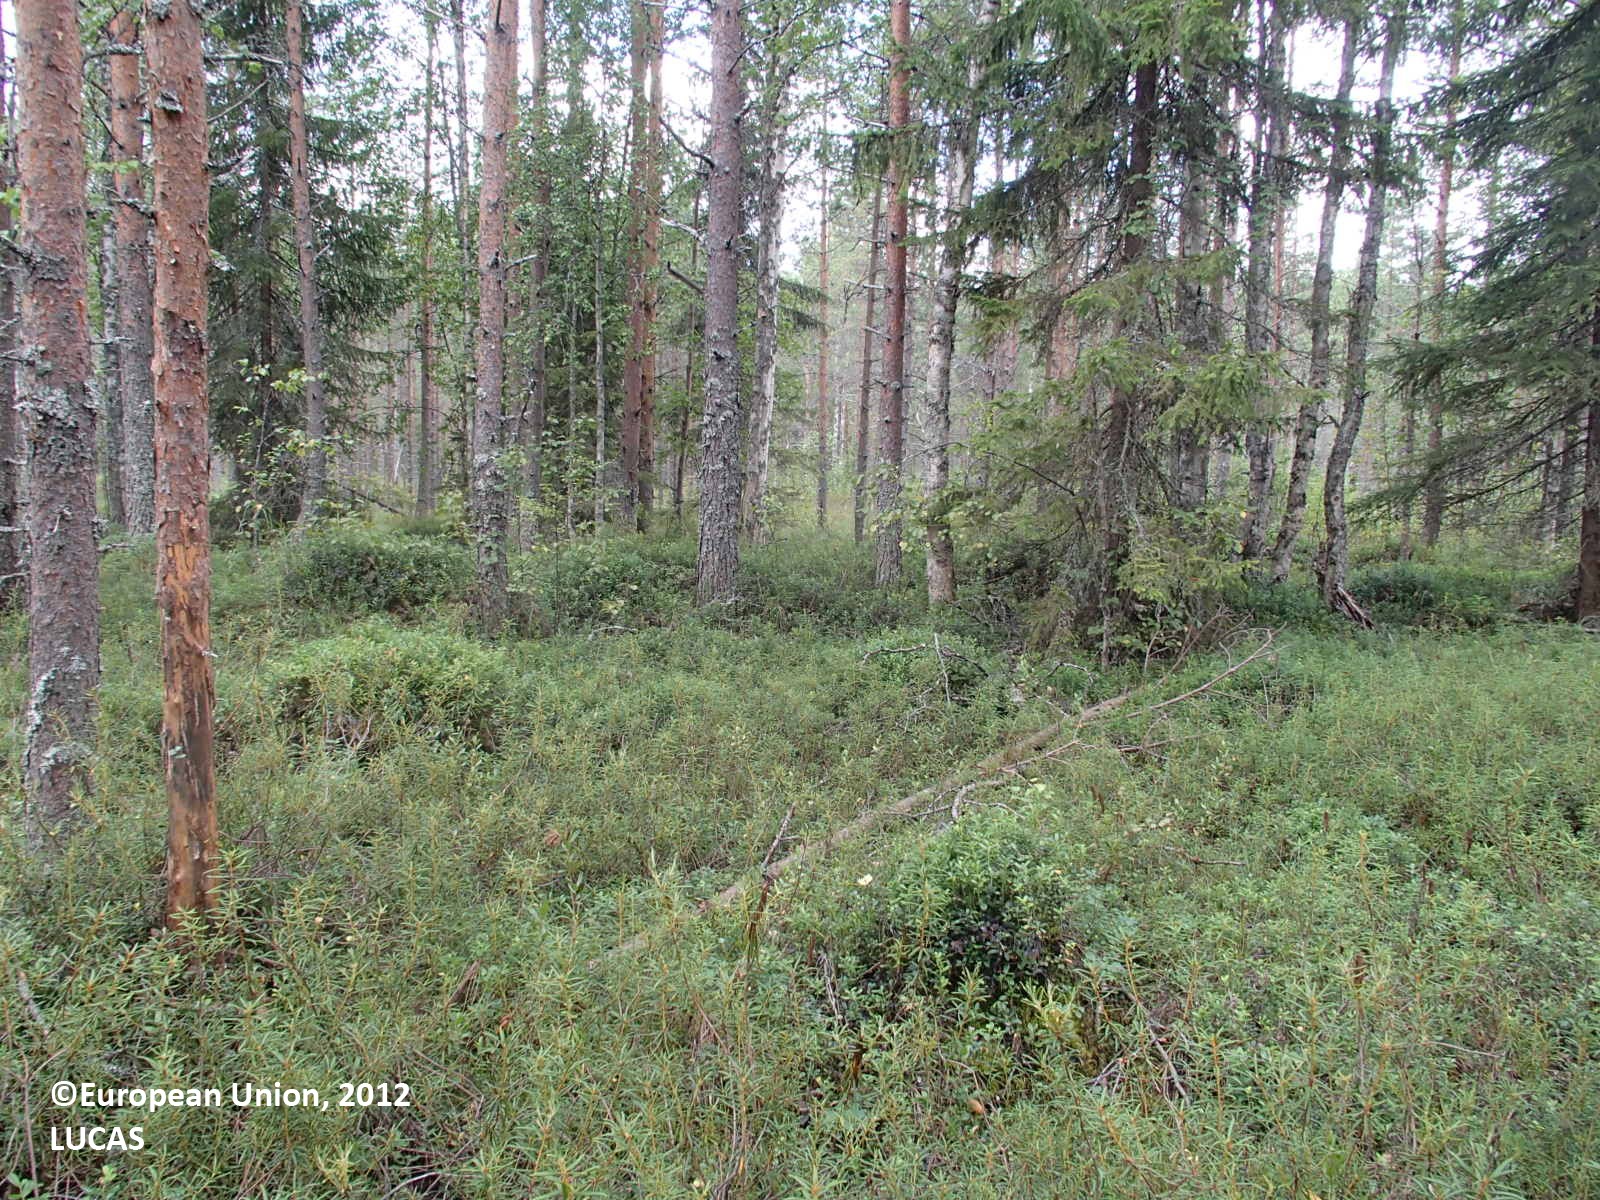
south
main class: Woodland
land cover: Other coniferous woodland
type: boreal forest
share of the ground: > 75 %
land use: Forestry
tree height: > 5 m
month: August
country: FI
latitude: 63.7875
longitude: 27.9632
